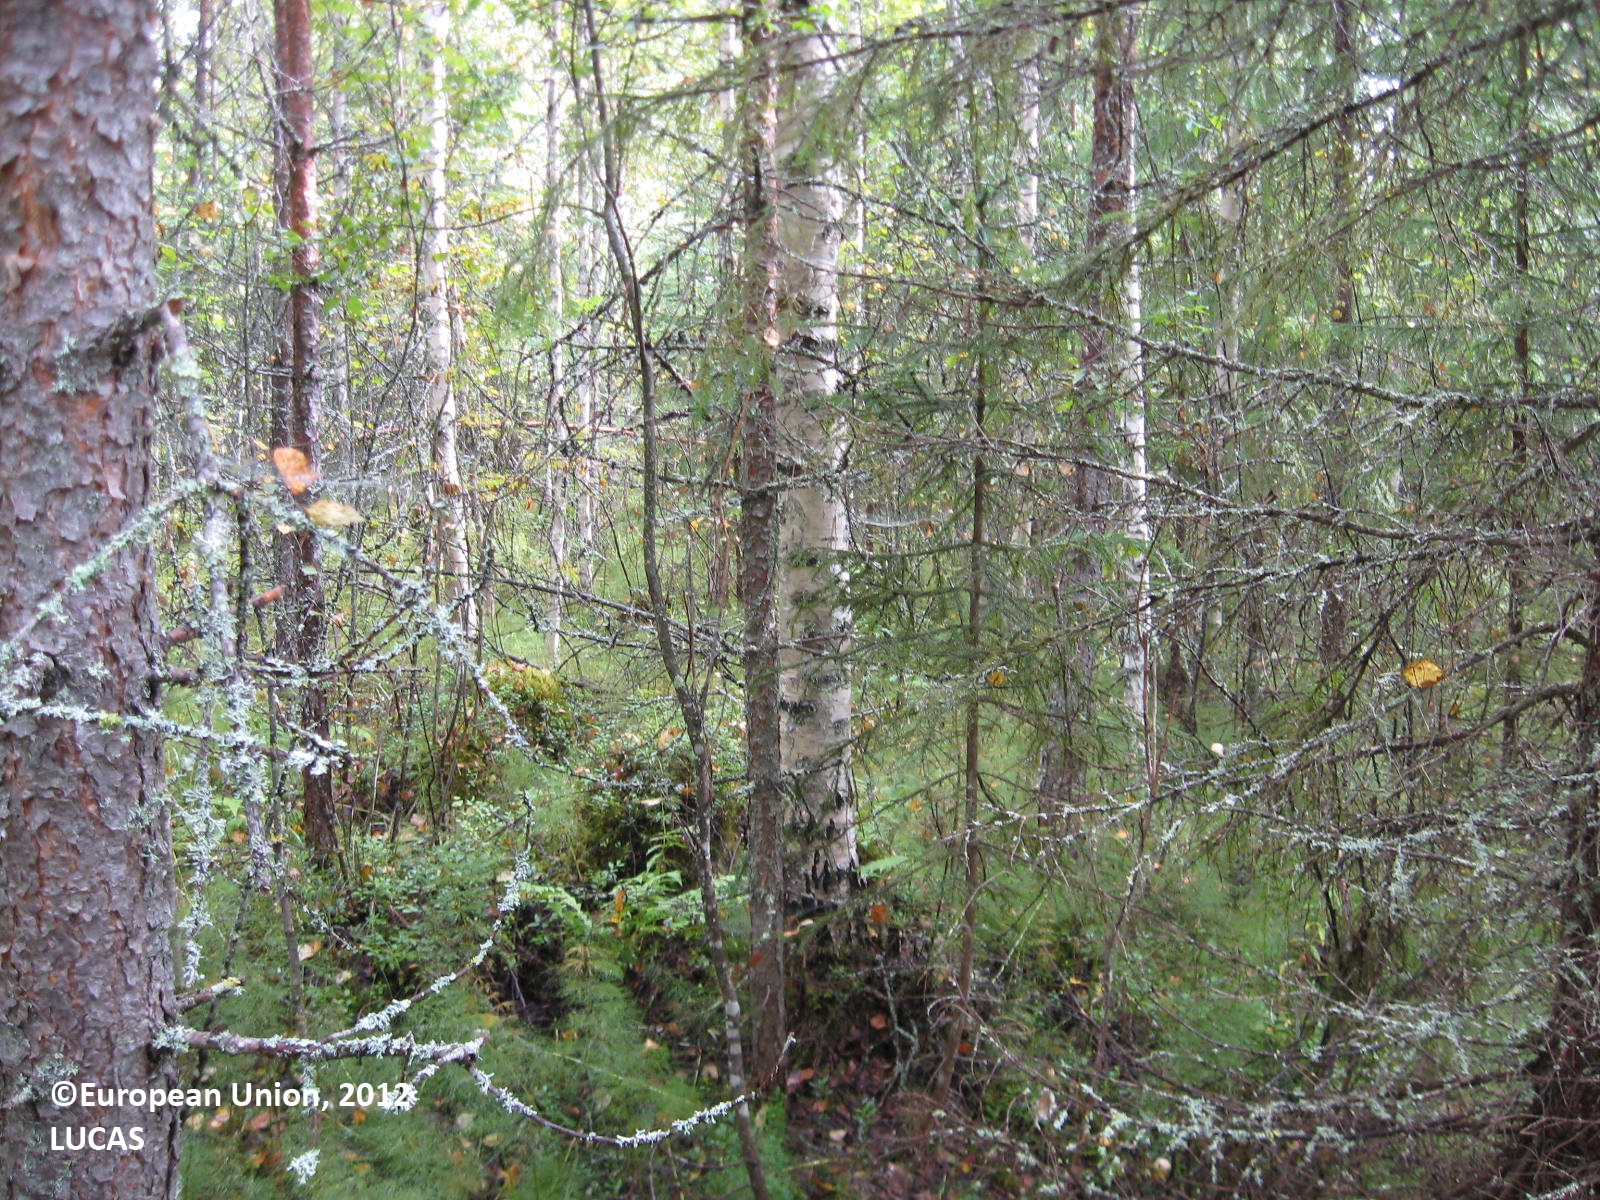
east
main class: Woodland
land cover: Other mixed woodland
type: boreal forest
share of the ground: > 75 %
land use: Forestry
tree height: > 5 m
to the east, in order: Other mixed woodland; Ditches and canals; Abandoned hedges; Grass margins; Paved roads, cycling and walking lanes; Grass margins; Ditches and canals; Other mixed woodland; Ditches and canals; Pine dominated mixed woodland; Ditches and canals; Pine dominated mixed woodland; Ditches and canals; Pine dominated coniferous woodland
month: August
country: FI
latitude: 63.4655
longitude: 29.8021
